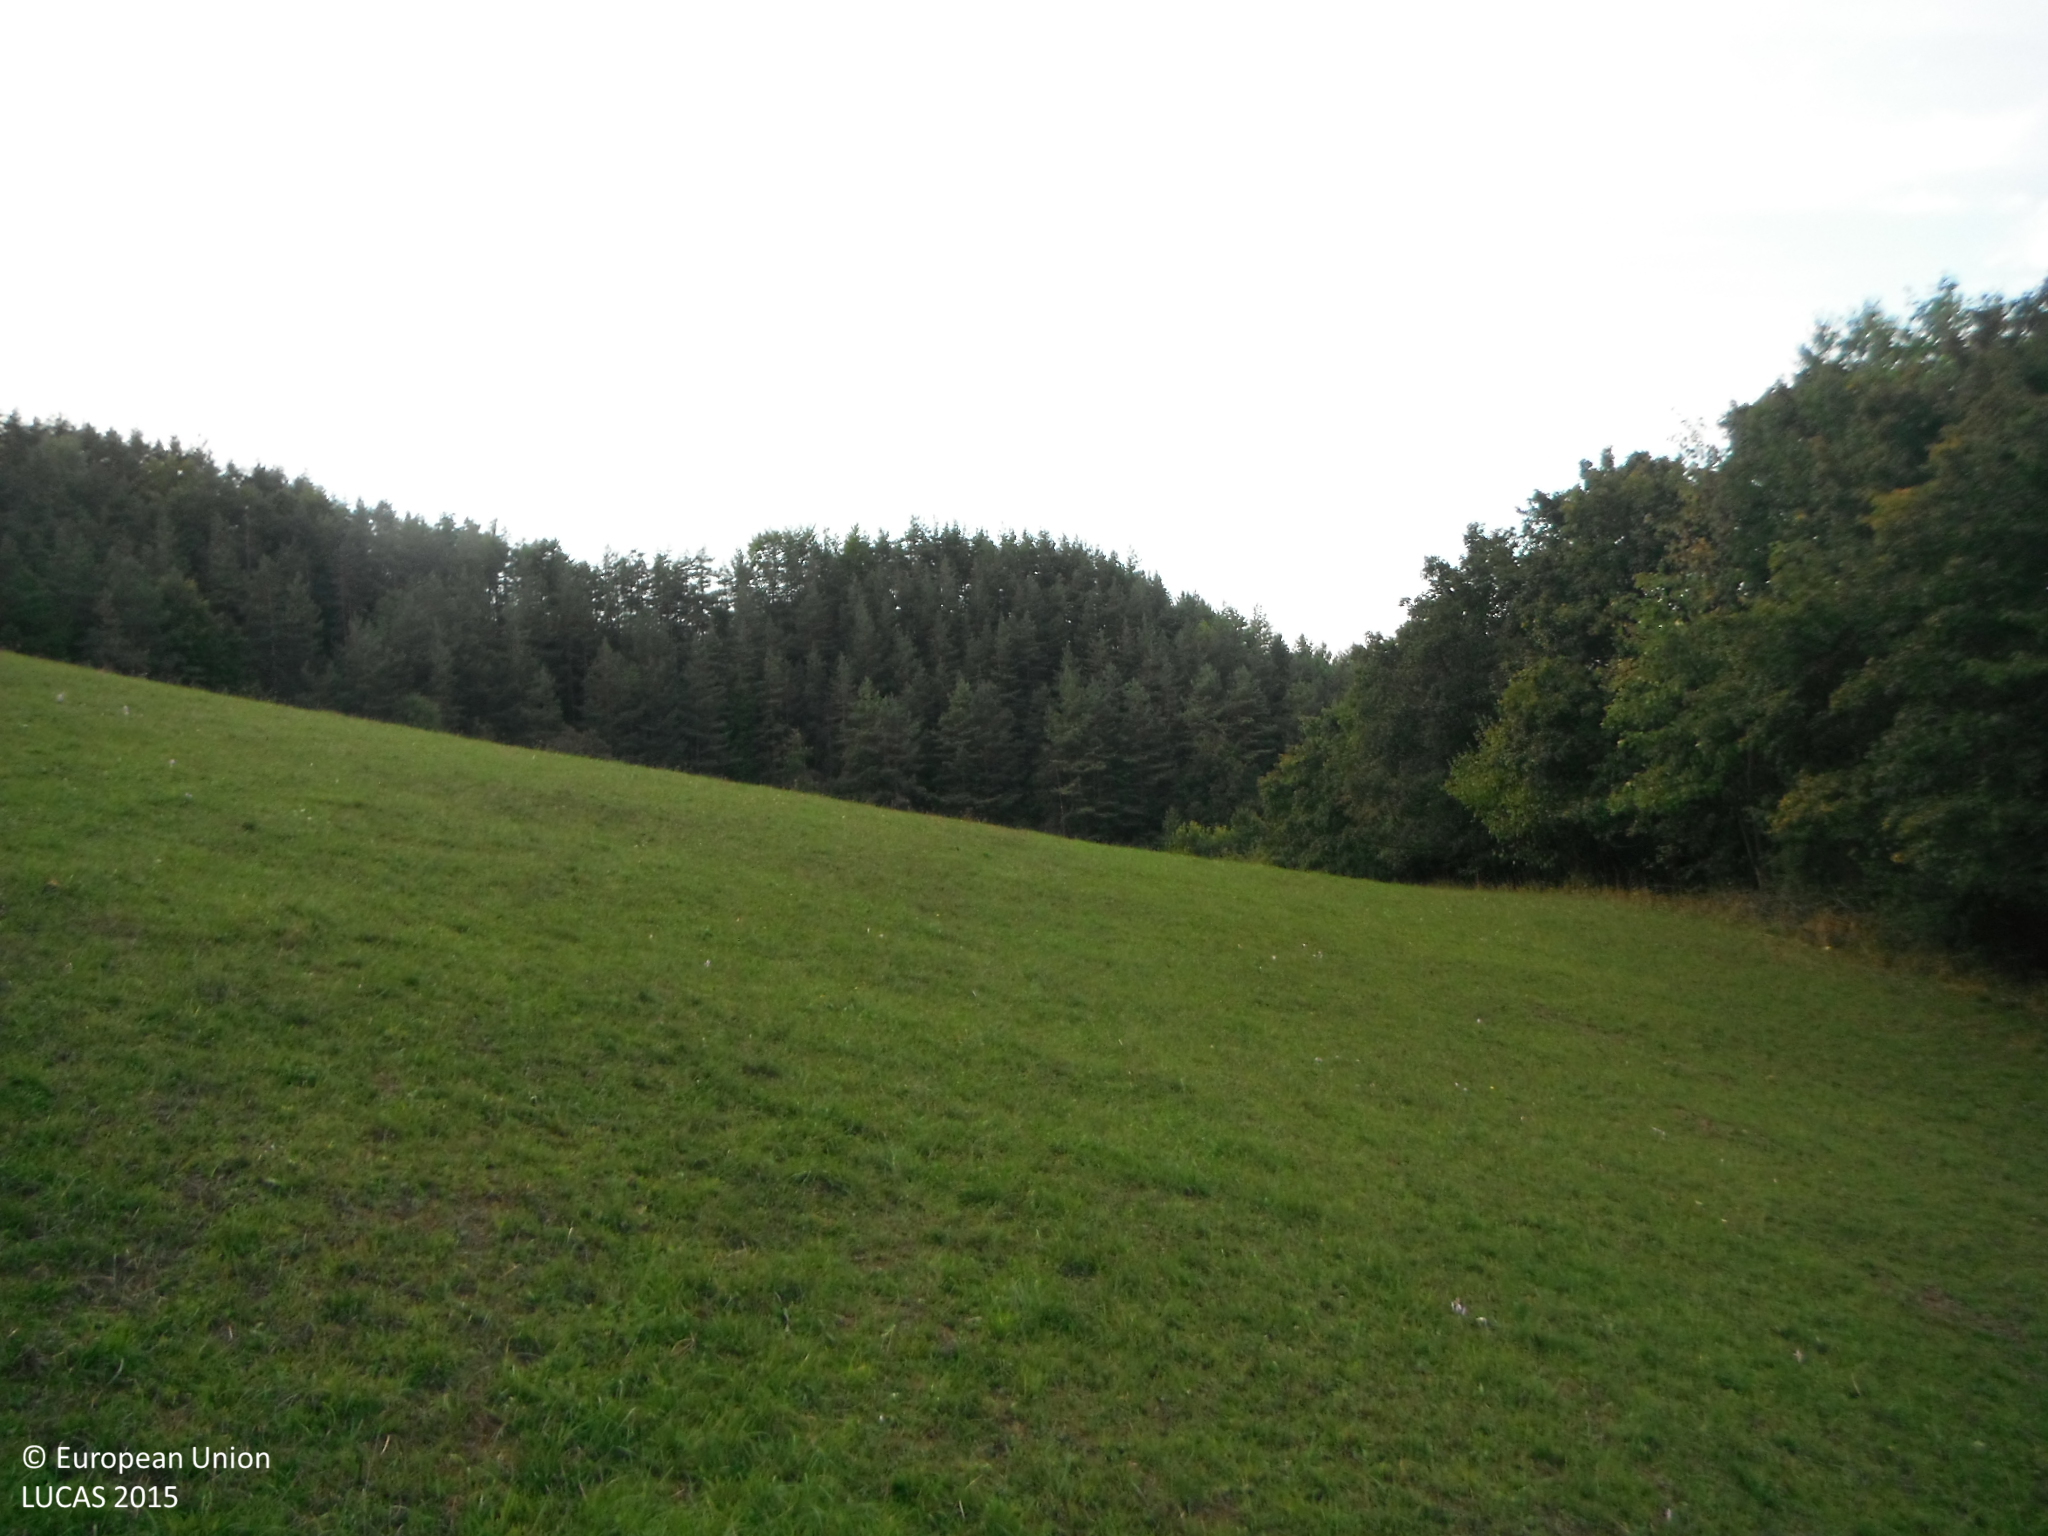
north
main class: Grassland
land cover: Grassland without tree/shrub cover
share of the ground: > 75 %
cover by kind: herbaceous plants 100 %
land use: Agriculture (excluding fallow land and kitchen gardens)
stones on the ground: < 10 %
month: September
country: SK
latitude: 48.8811
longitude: 18.3758
